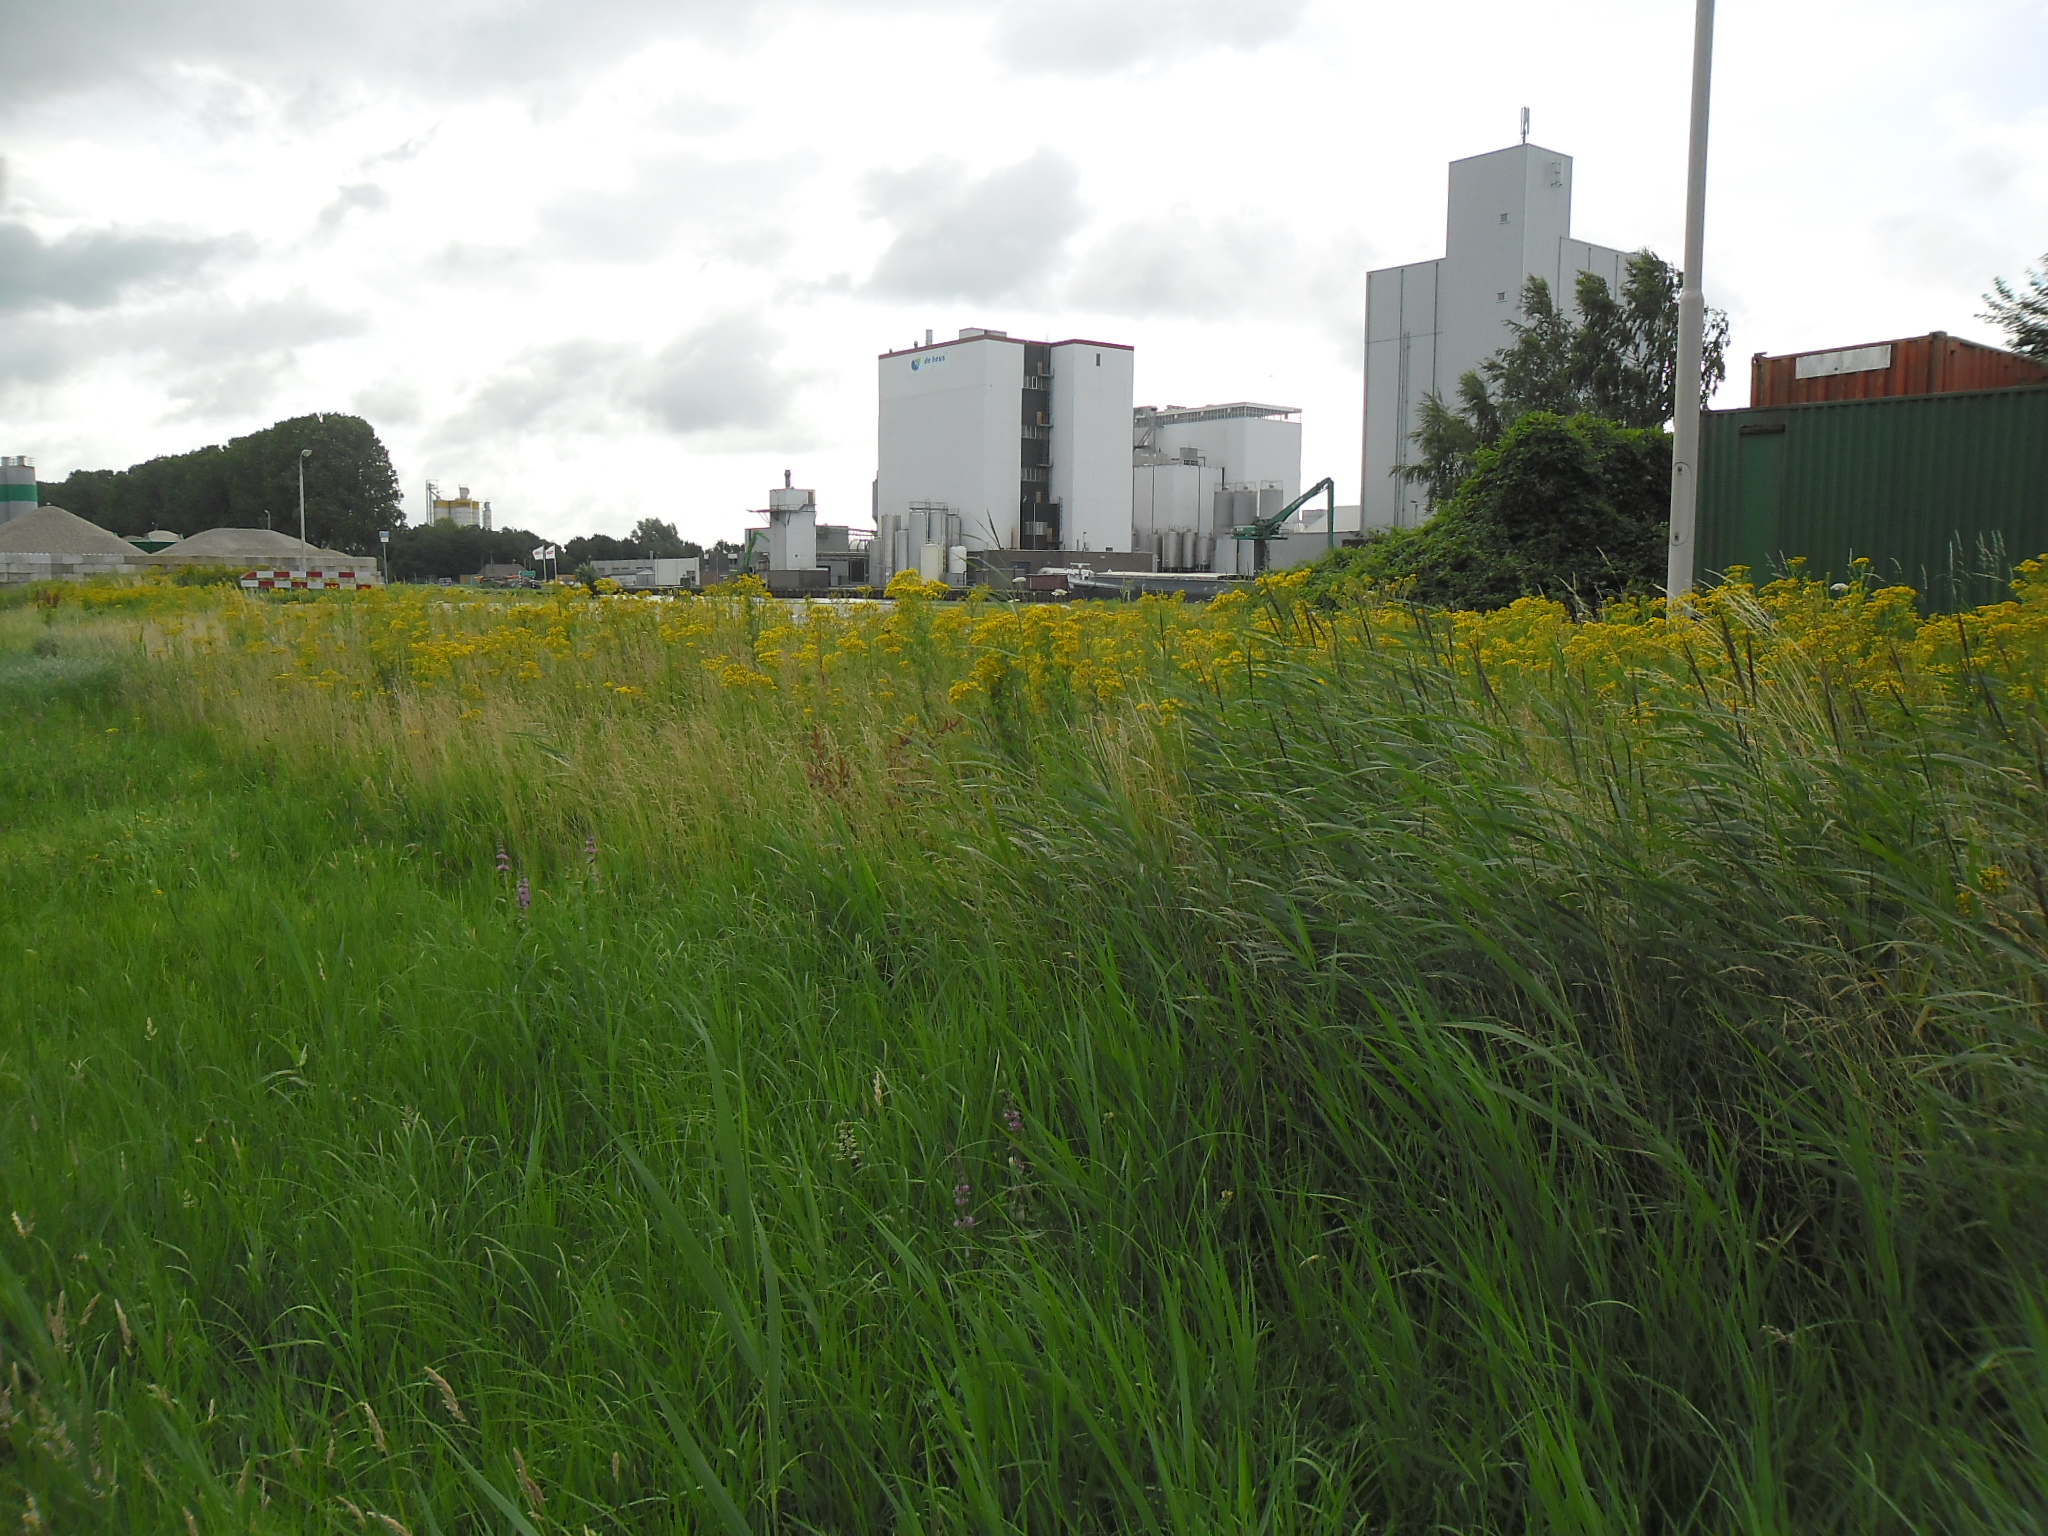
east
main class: Grassland
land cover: Grassland without tree/shrub cover
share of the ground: > 75 %
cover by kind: herbaceous plants 100 %
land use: Logistics and storage
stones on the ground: < 10 %
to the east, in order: Grassland without tree/shrub cover; Spontaneously vegetated surfaces; Paved roads, cycling and walking lanes; Grassland without tree/shrub cover; Inland fresh running water
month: July
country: NL
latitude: 52.6936
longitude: 6.1674
